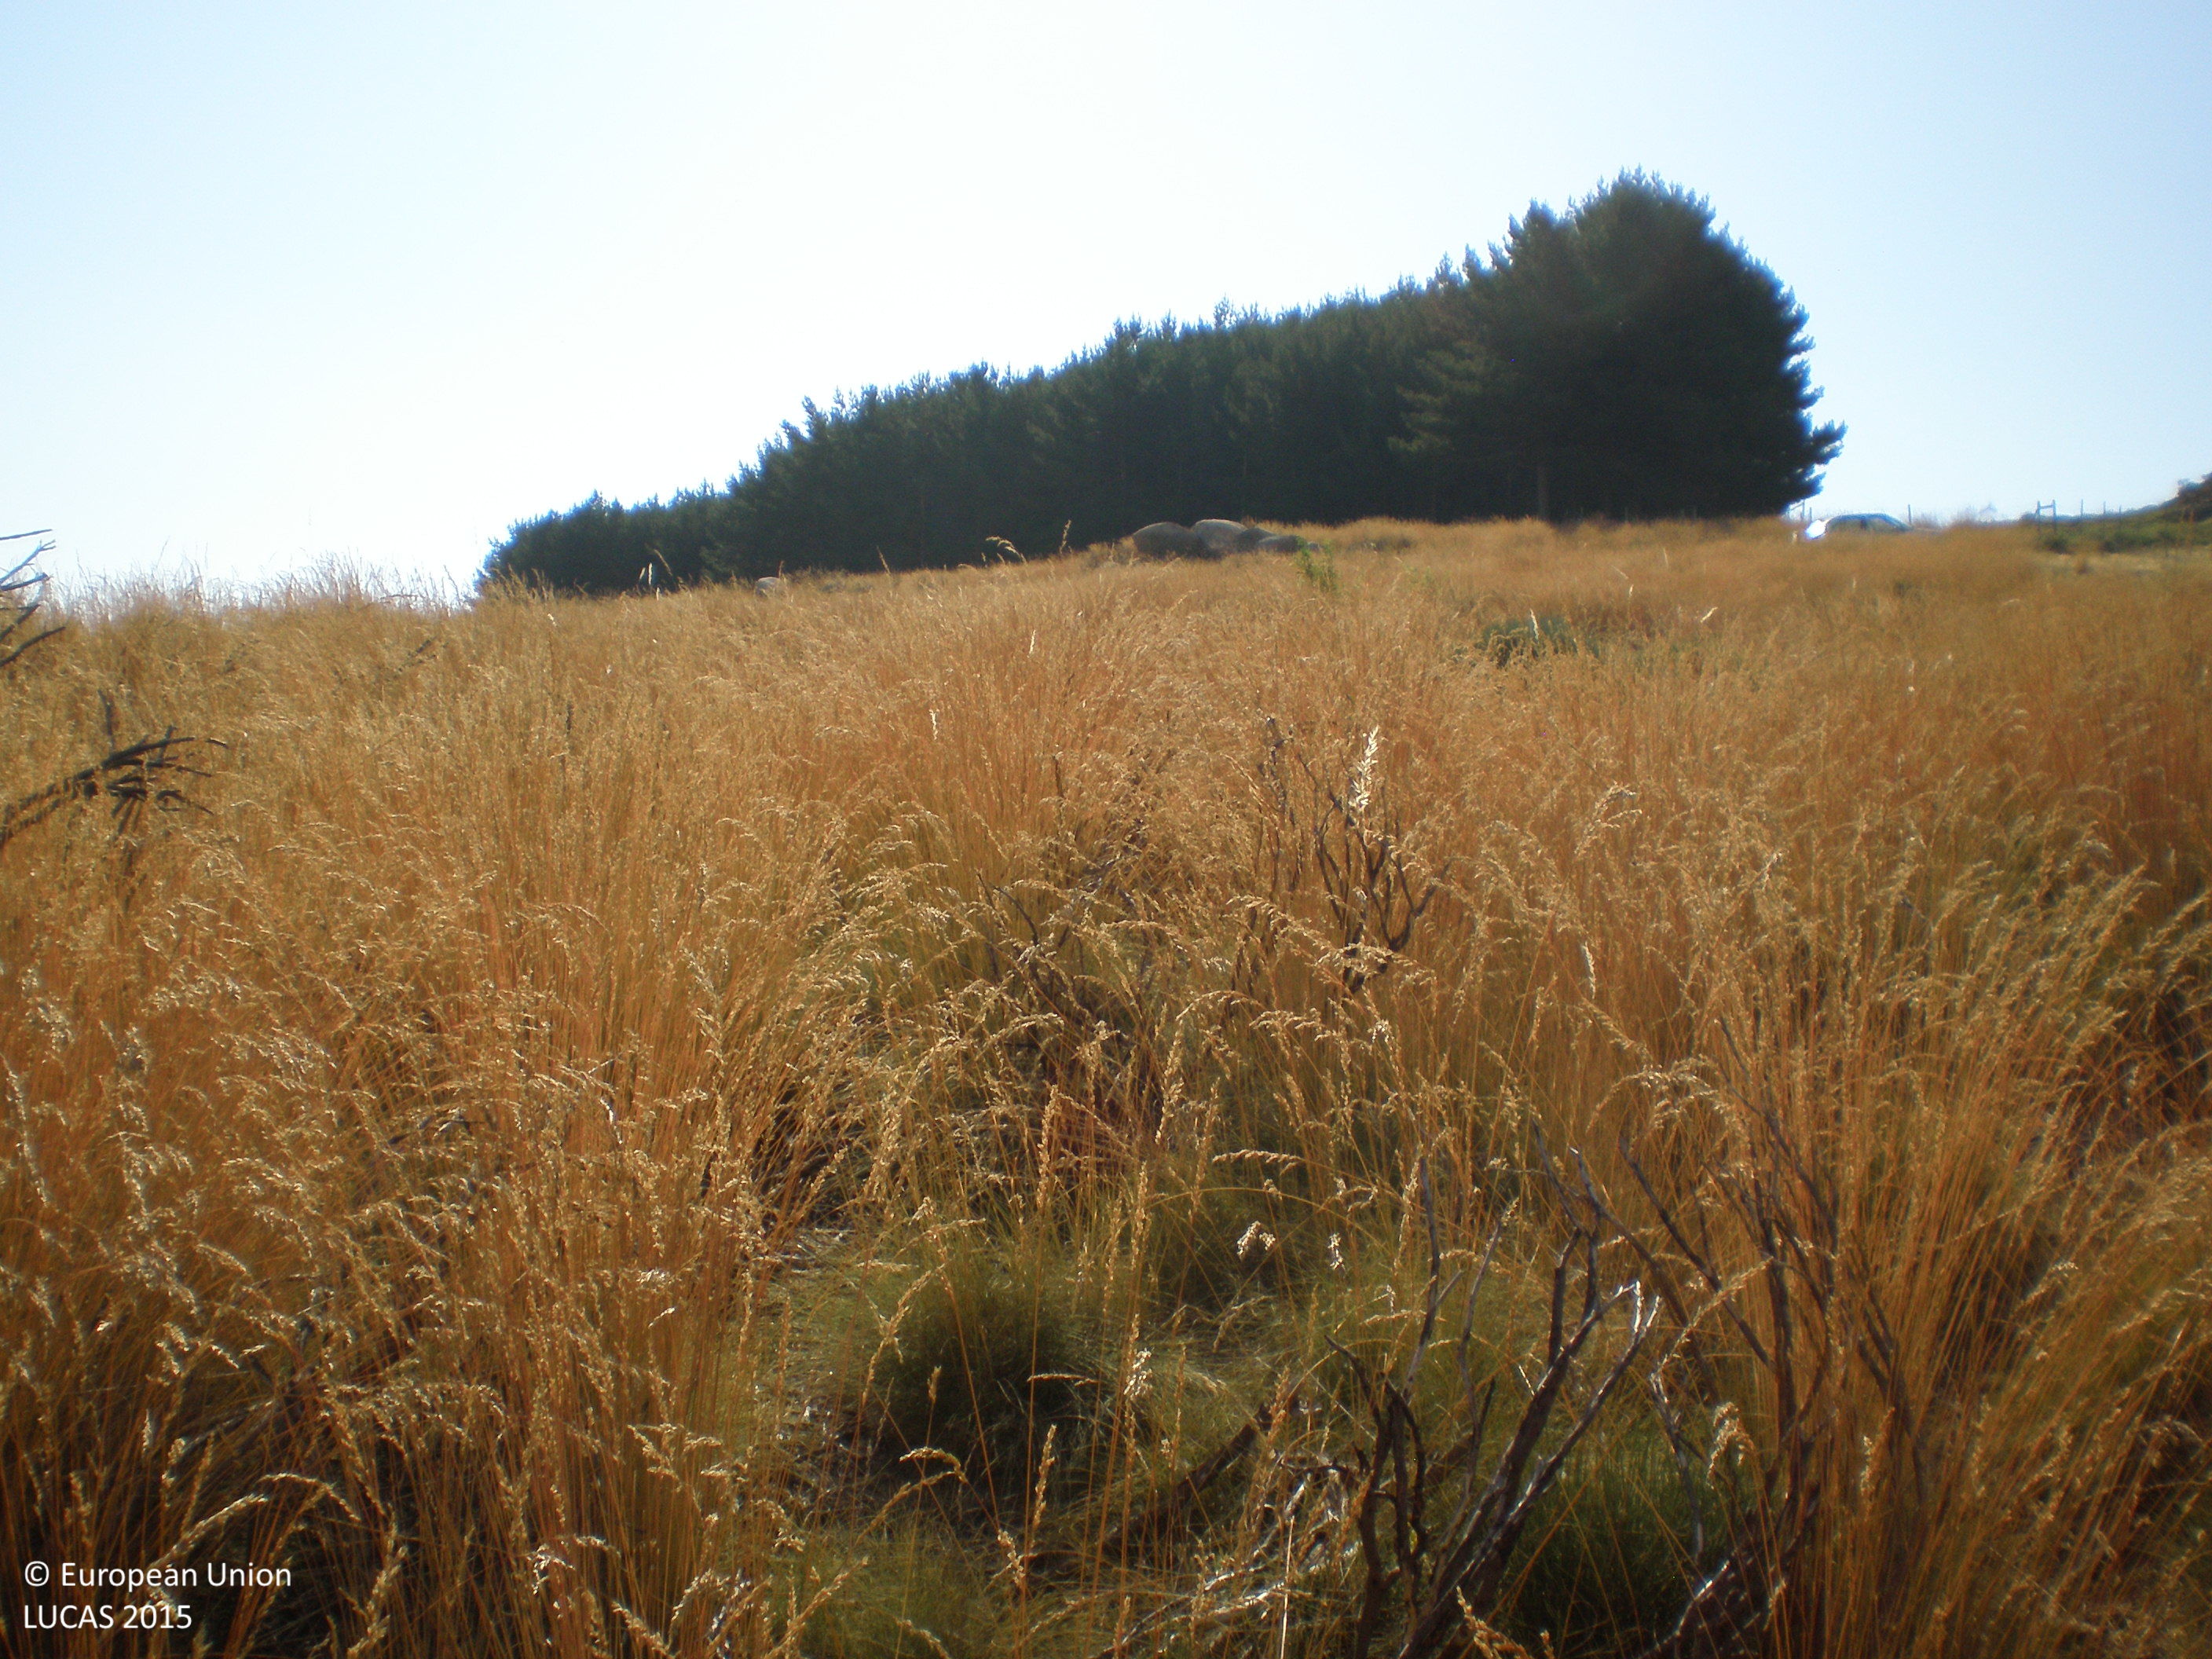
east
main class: Shrubland
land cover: Shrubland without tree cover
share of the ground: > 75 %
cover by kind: shrubs 80 %, herbaceous plants 20 %
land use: Abandoned areas
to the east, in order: Shrubland without tree cover; Tracks; Shrubland without tree cover; Tracks; Shrubland without tree cover; Dry stone walls; Pine dominated coniferous woodland; Dry stone walls; Tracks; Dry stone walls; Pine dominated coniferous woodland
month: July
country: ES
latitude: 40.4158
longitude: -5.0846
